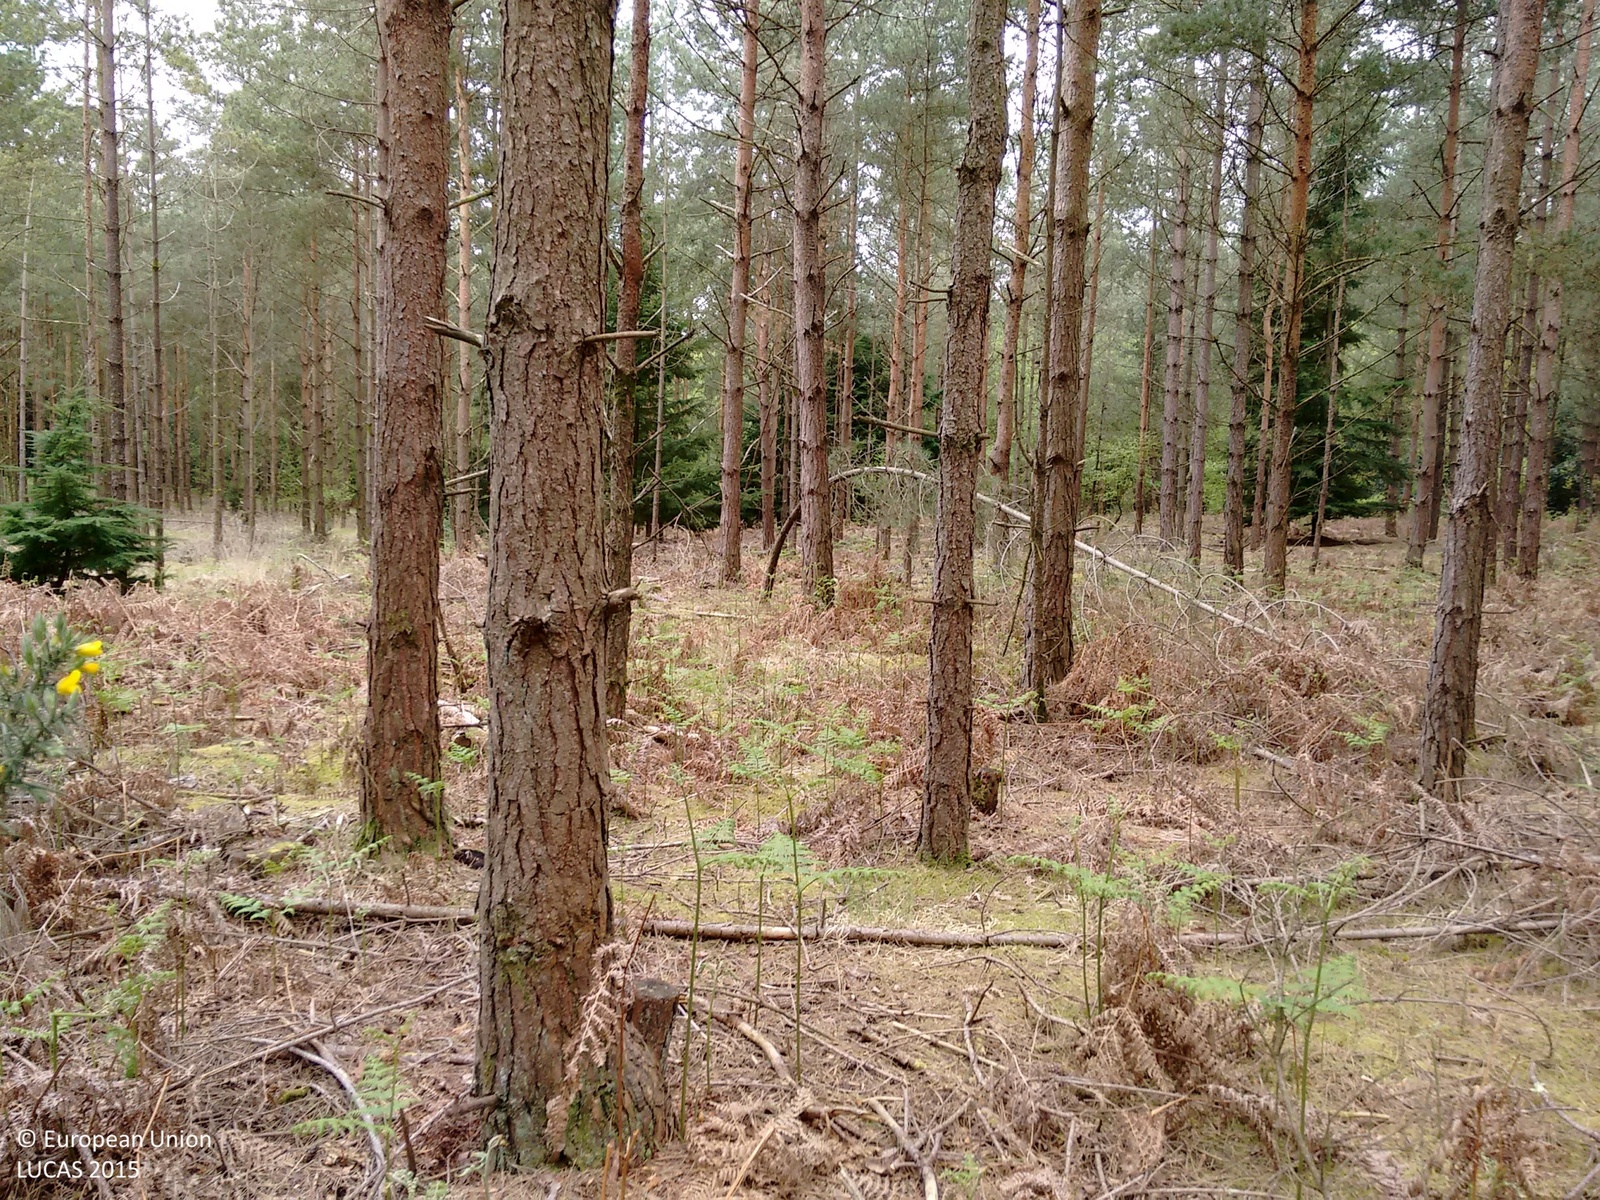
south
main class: Woodland
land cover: Pine dominated coniferous woodland
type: hemiboreal forest and nemoral coniferous forest and mixed broadleaved-coniferous forest
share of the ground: > 75 %
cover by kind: coniferous forest trees 100 %
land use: Forestry
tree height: > 5 m
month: May
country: GB
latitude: 50.8002
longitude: -1.8467
